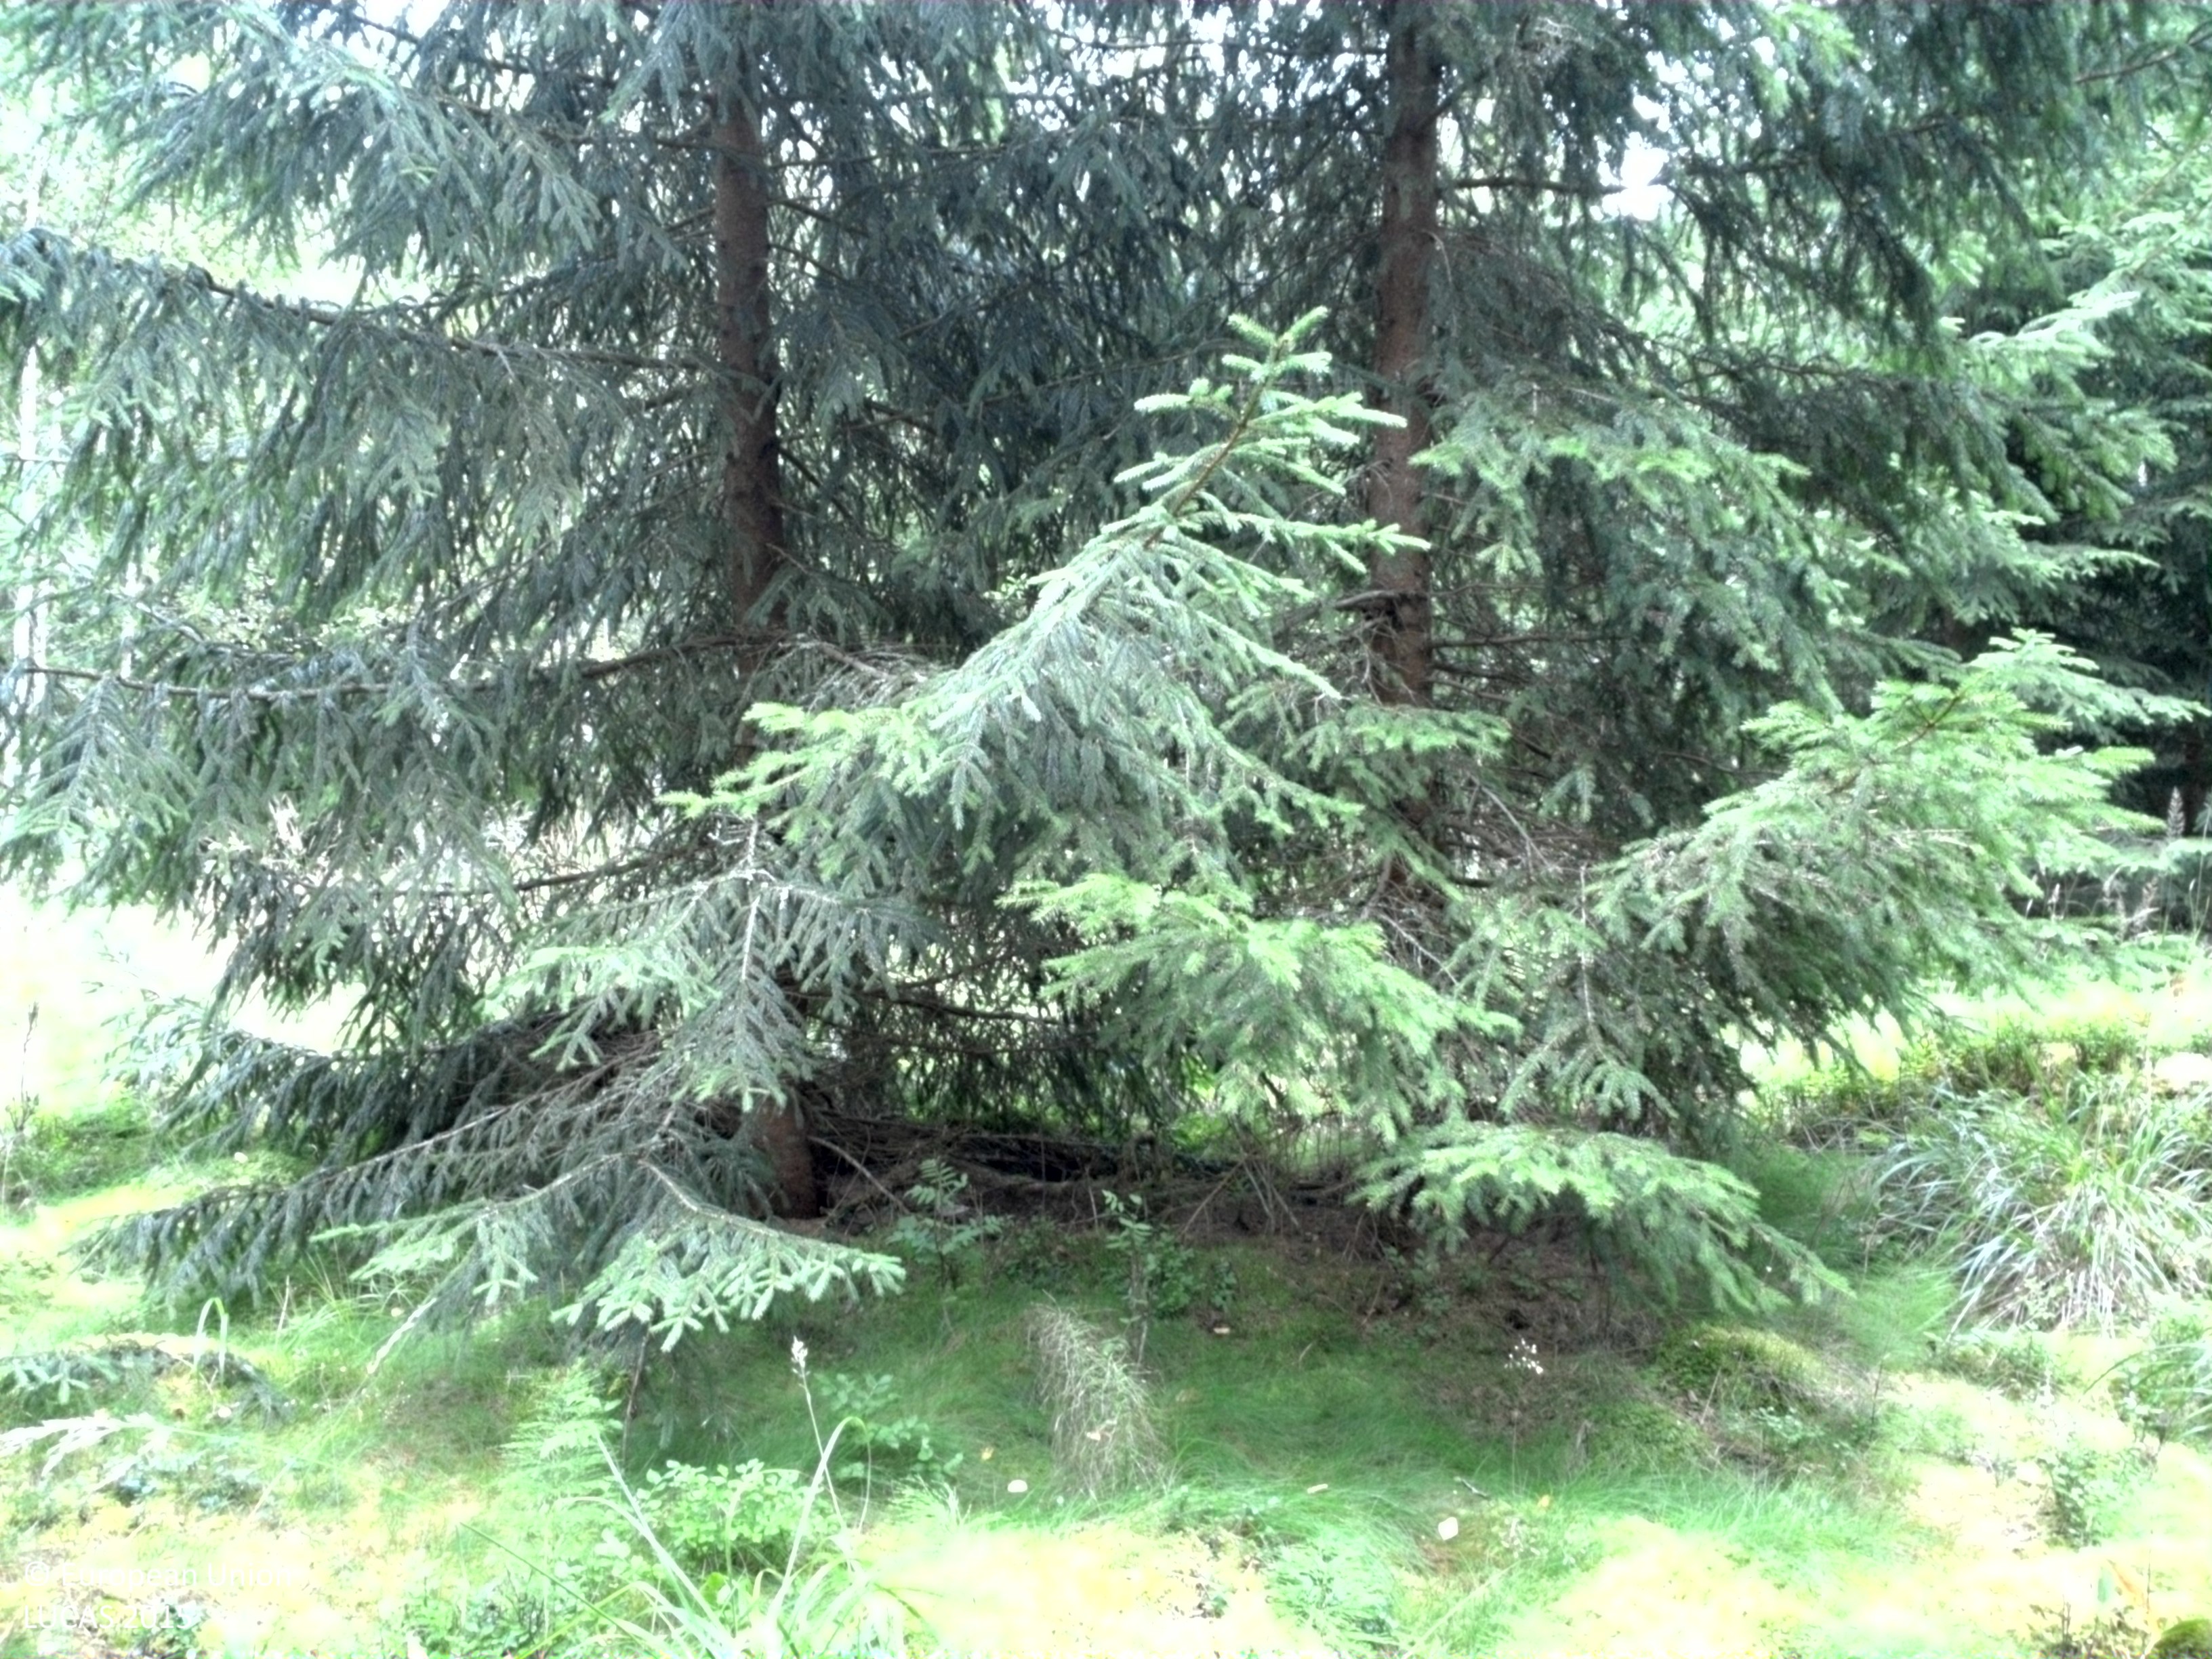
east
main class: Woodland
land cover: Spruce dominated coniferous woodland
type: boreal forest
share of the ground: 50 - 75 %
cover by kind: coniferous forest trees 65 %, broadleaved forest trees 10 %, herbaceous plants 10 %, lichens and mosses 10 %, shrubs 5 %
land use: Forestry
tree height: > 5 m
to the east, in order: Spruce dominated coniferous woodland; Spruce dominated mixed woodland; Broadleaved woodland; Spruce dominated mixed woodland; Spruce dominated coniferous woodland; Grassland without tree/shrub cover; Spruce dominated coniferous woodland; Spruce dominated mixed woodland
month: August
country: SE
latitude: 59.8678
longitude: 16.5096
